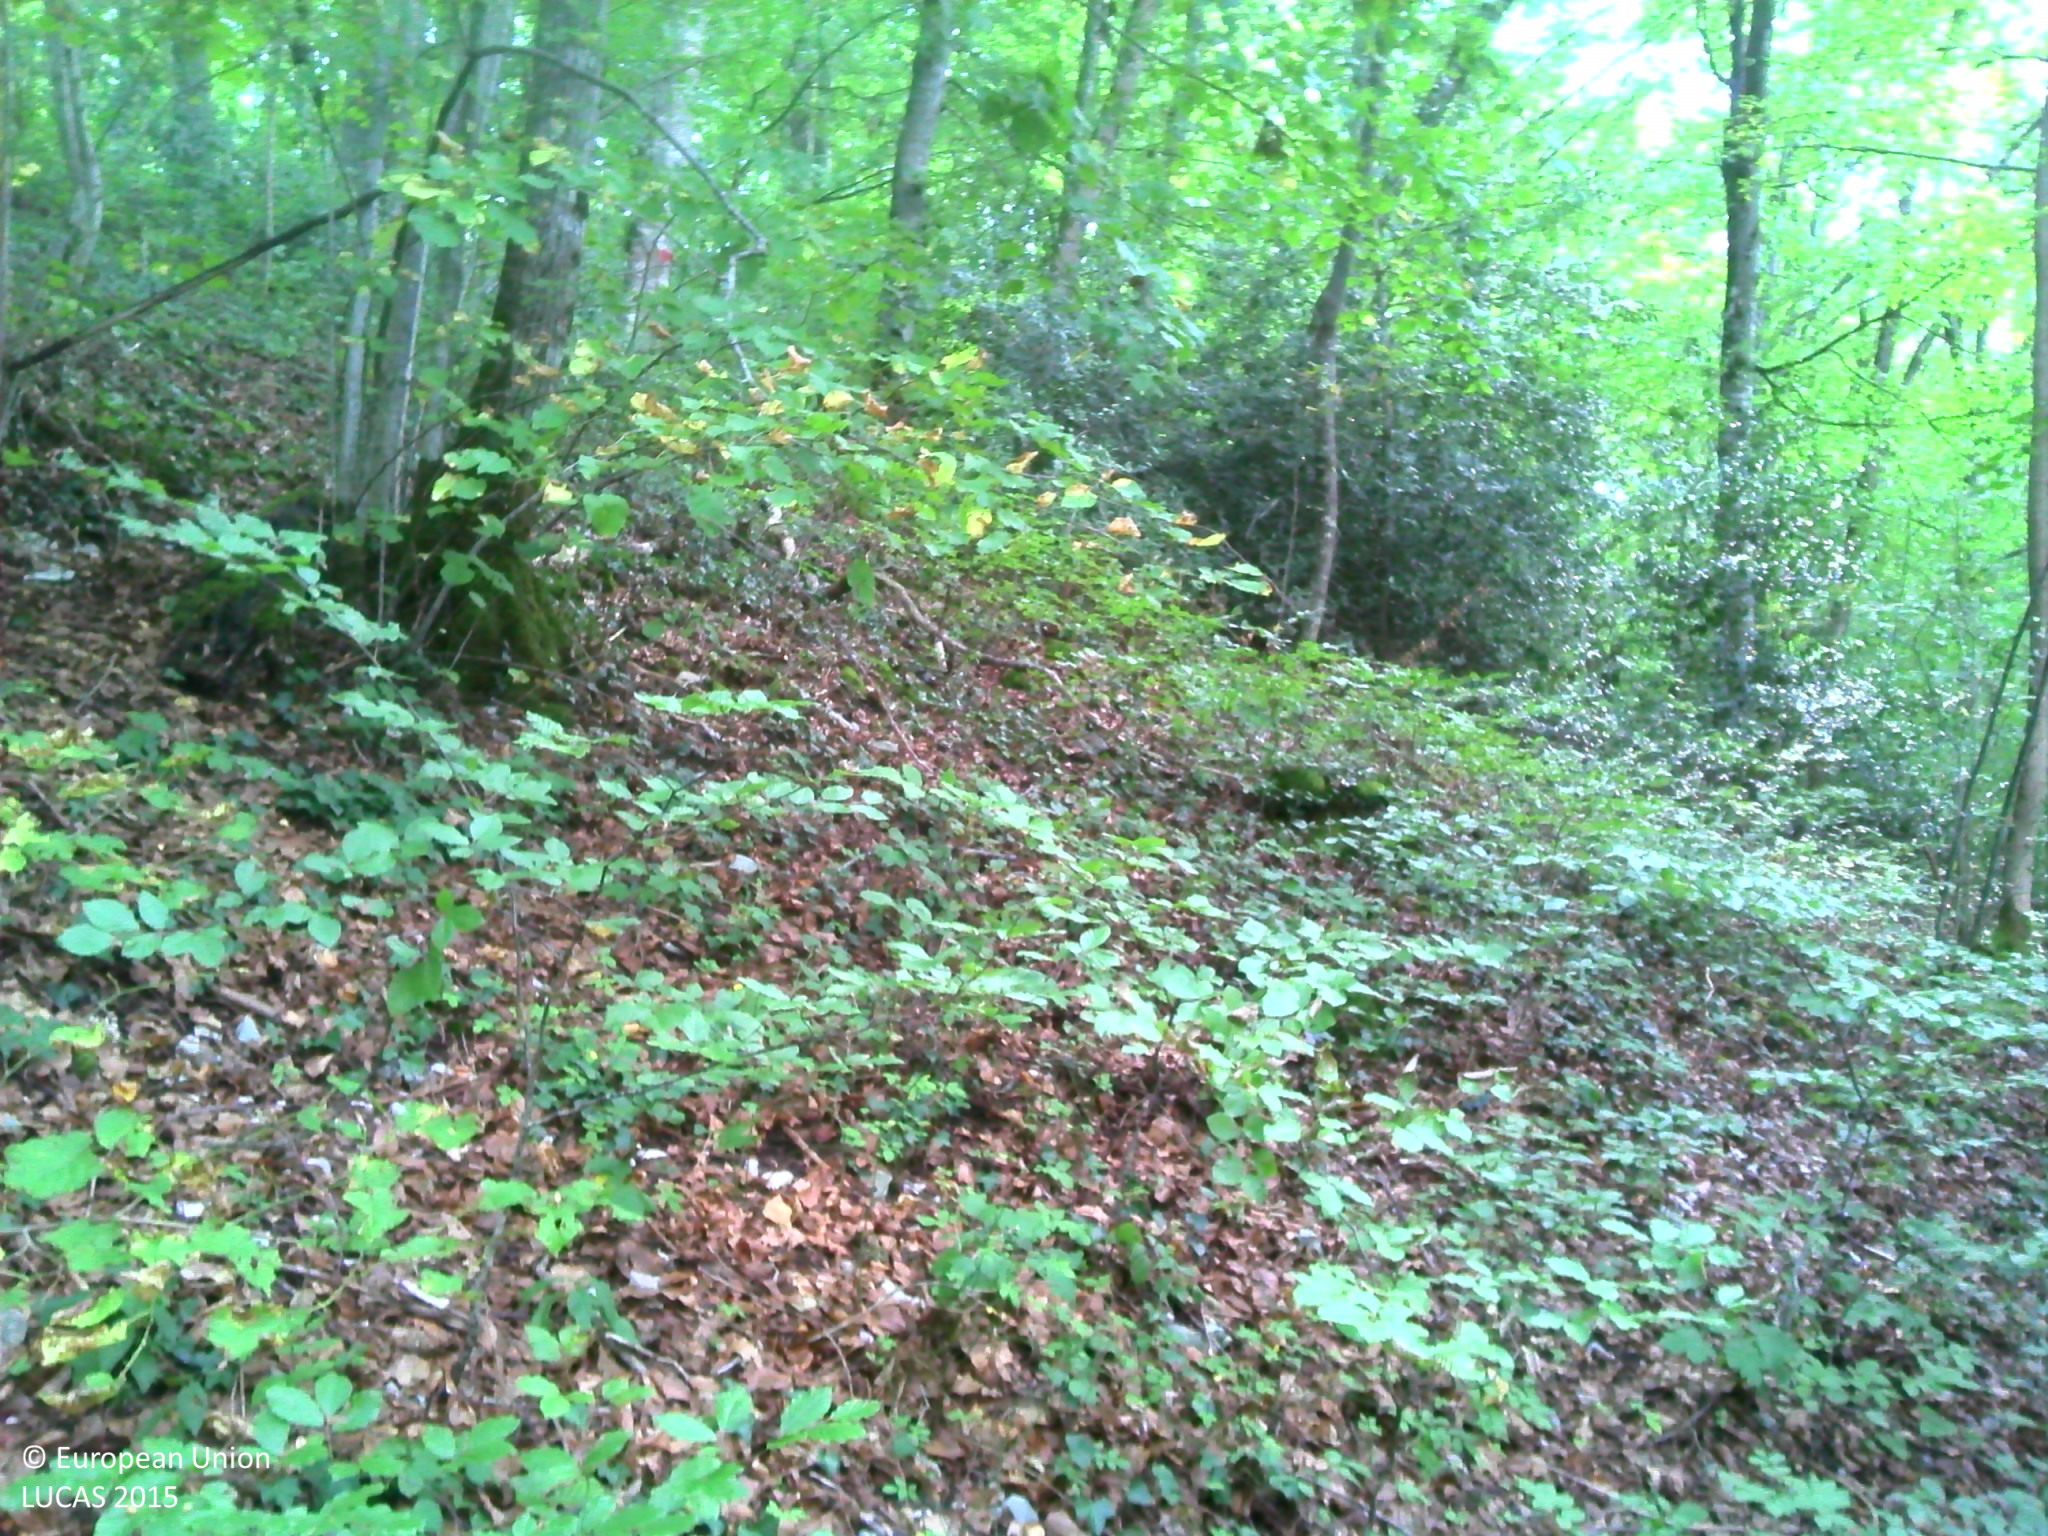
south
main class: Woodland
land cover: Broadleaved woodland
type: beech forest
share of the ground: > 75 %
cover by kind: broadleaved forest trees 100 %
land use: Forestry
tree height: > 5 m
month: September
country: FR
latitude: 47.4615
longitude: 6.3801
